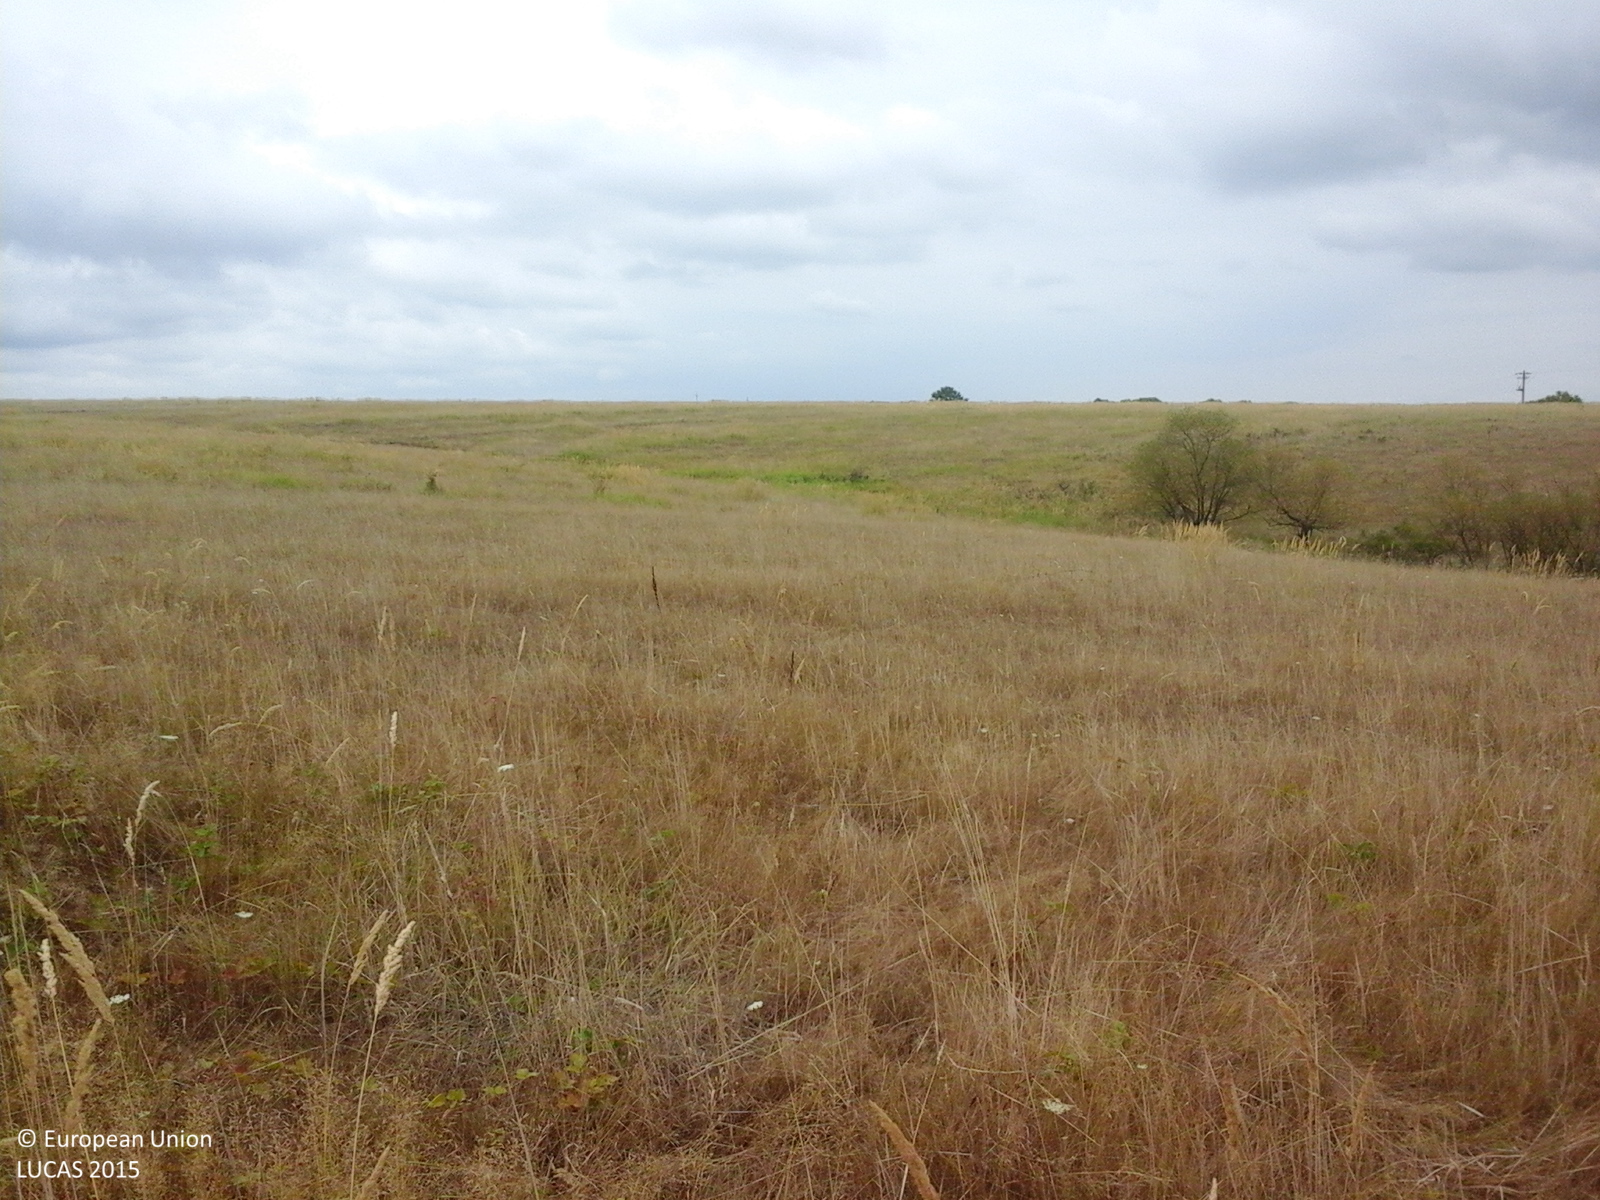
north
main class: Grassland
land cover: Grassland without tree/shrub cover
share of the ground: > 75 %
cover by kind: herbaceous plants 100 %
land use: Agriculture (excluding fallow land and kitchen gardens)
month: August
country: RO
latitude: 45.8922
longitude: 21.8307
